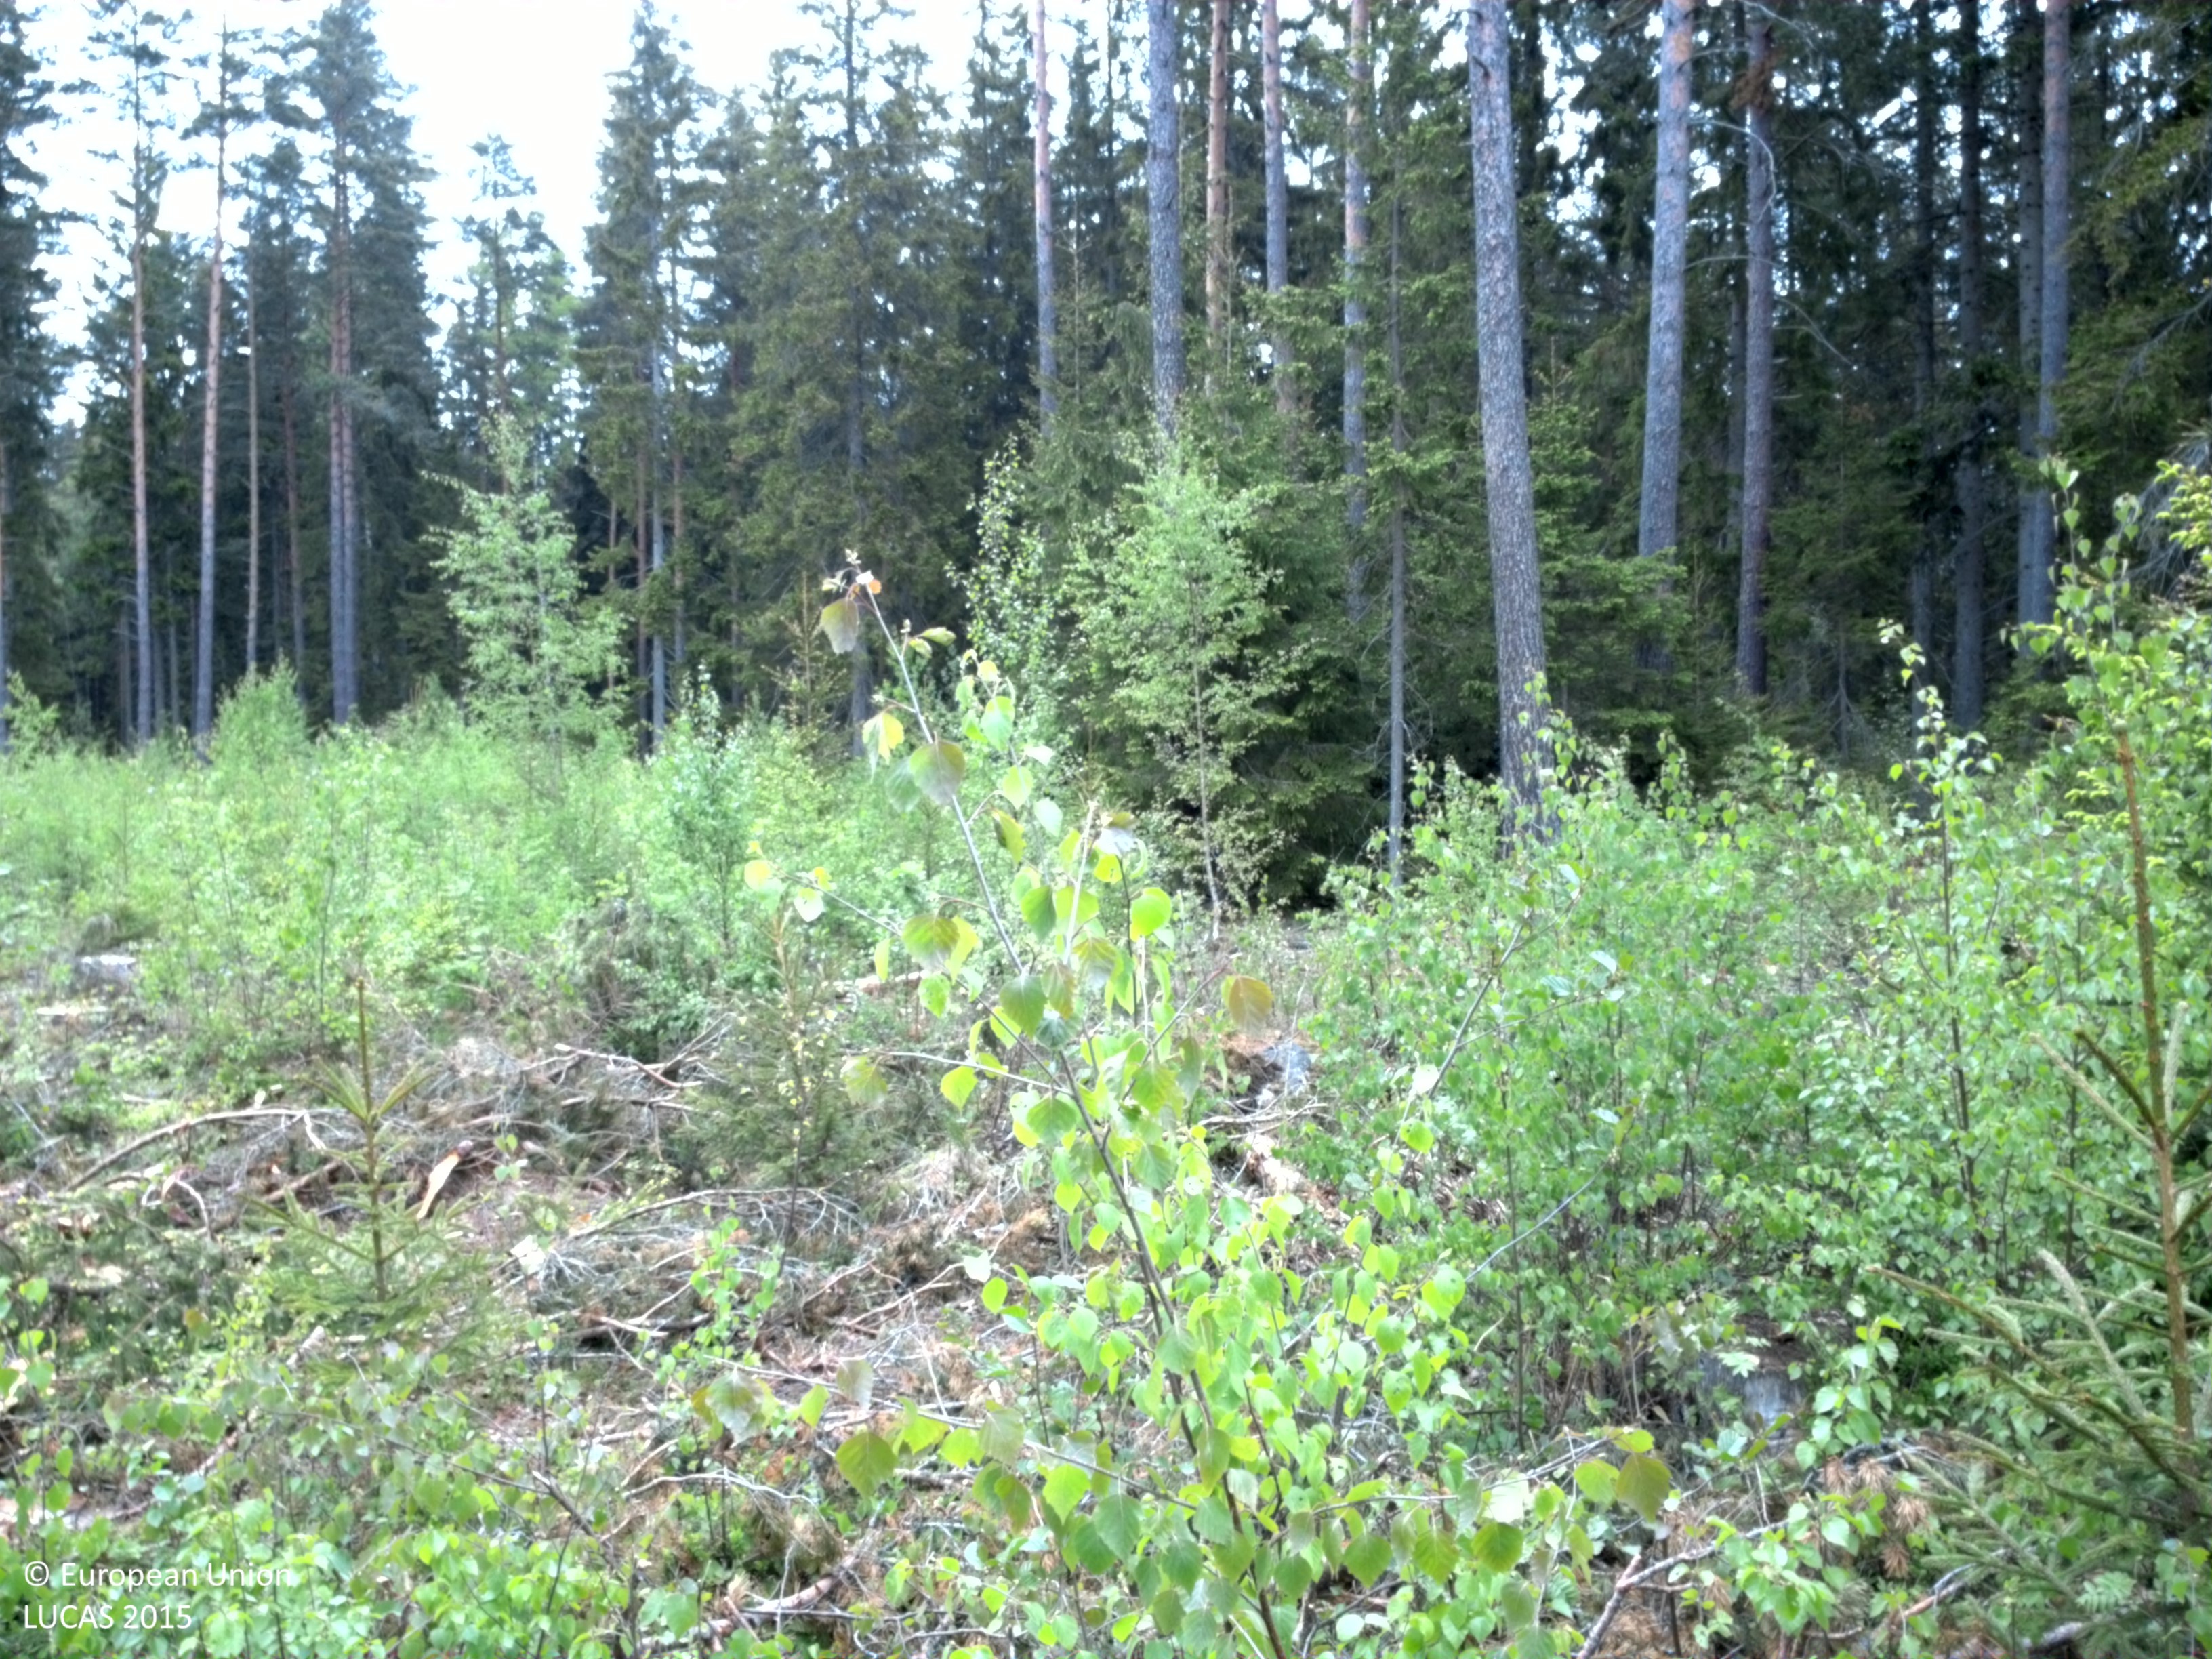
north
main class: Woodland
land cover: Spruce dominated mixed woodland
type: boreal forest
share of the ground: 50 - 75 %
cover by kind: broadleaved forest trees 35 %, coniferous forest trees 25 %, shrubs 15 %, herbaceous plants 15 %, lichens and mosses 10 %
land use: Forestry
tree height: < 5 m
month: May
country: SE
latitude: 57.3815
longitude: 15.6027
